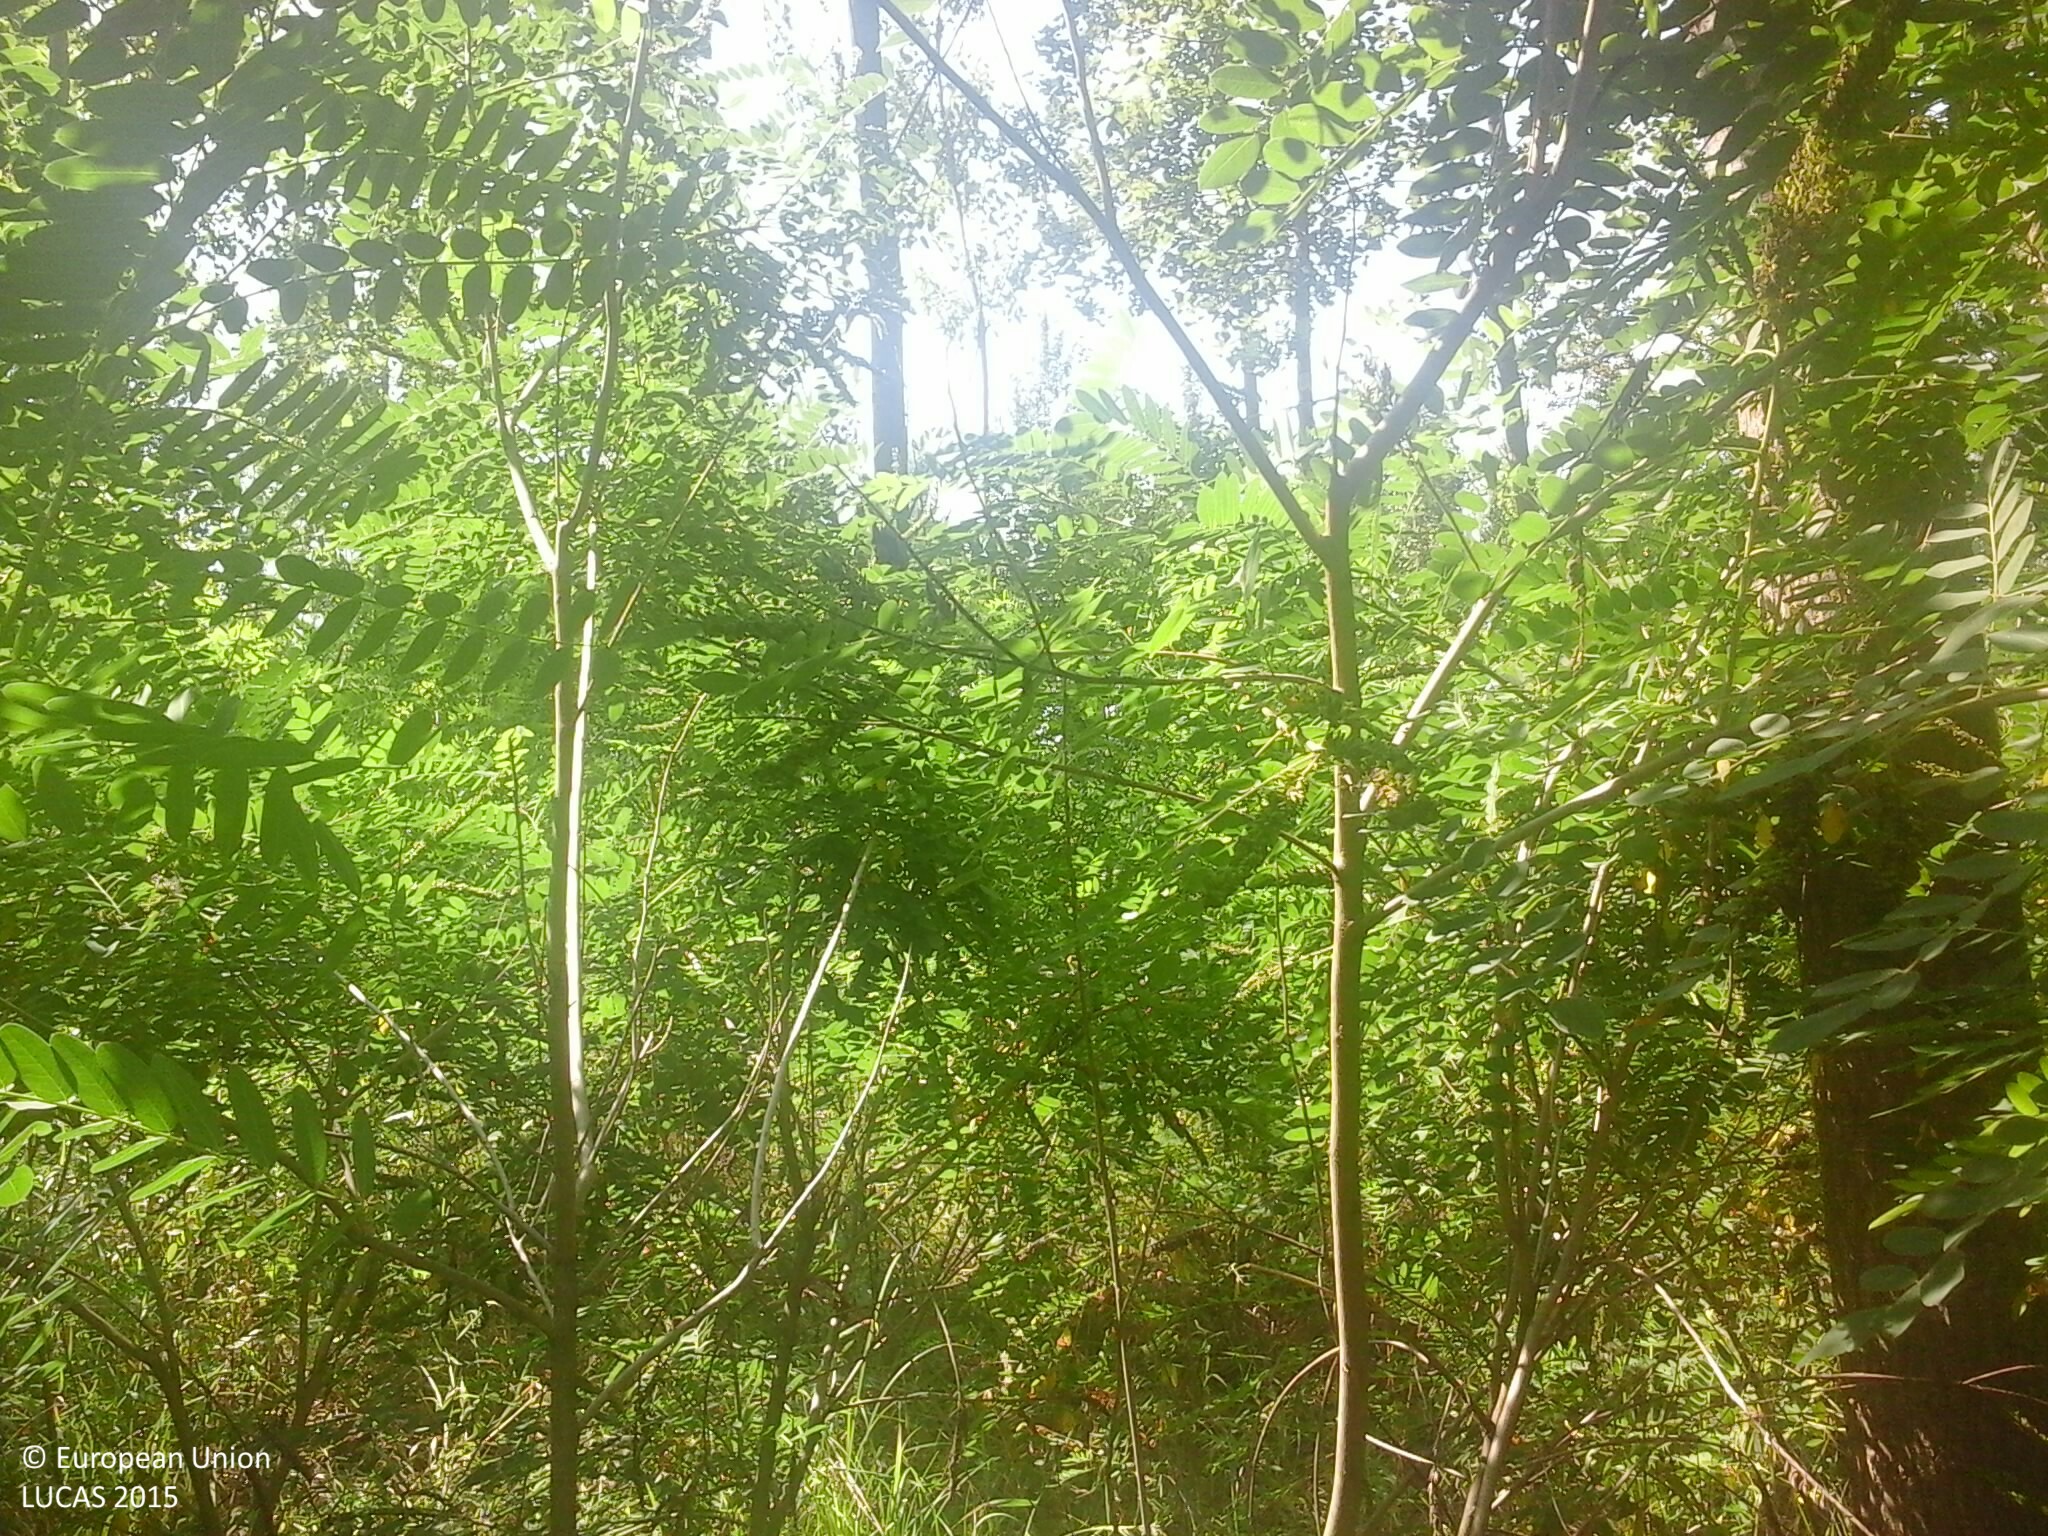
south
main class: Woodland
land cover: Broadleaved woodland
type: acidophilous oak and oak-birch forest
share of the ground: > 75 %
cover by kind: broadleaved forest trees 95 %, herbaceous plants 5 %
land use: Forestry
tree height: > 5 m
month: July
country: HU
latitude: 47.8873
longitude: 22.3741
